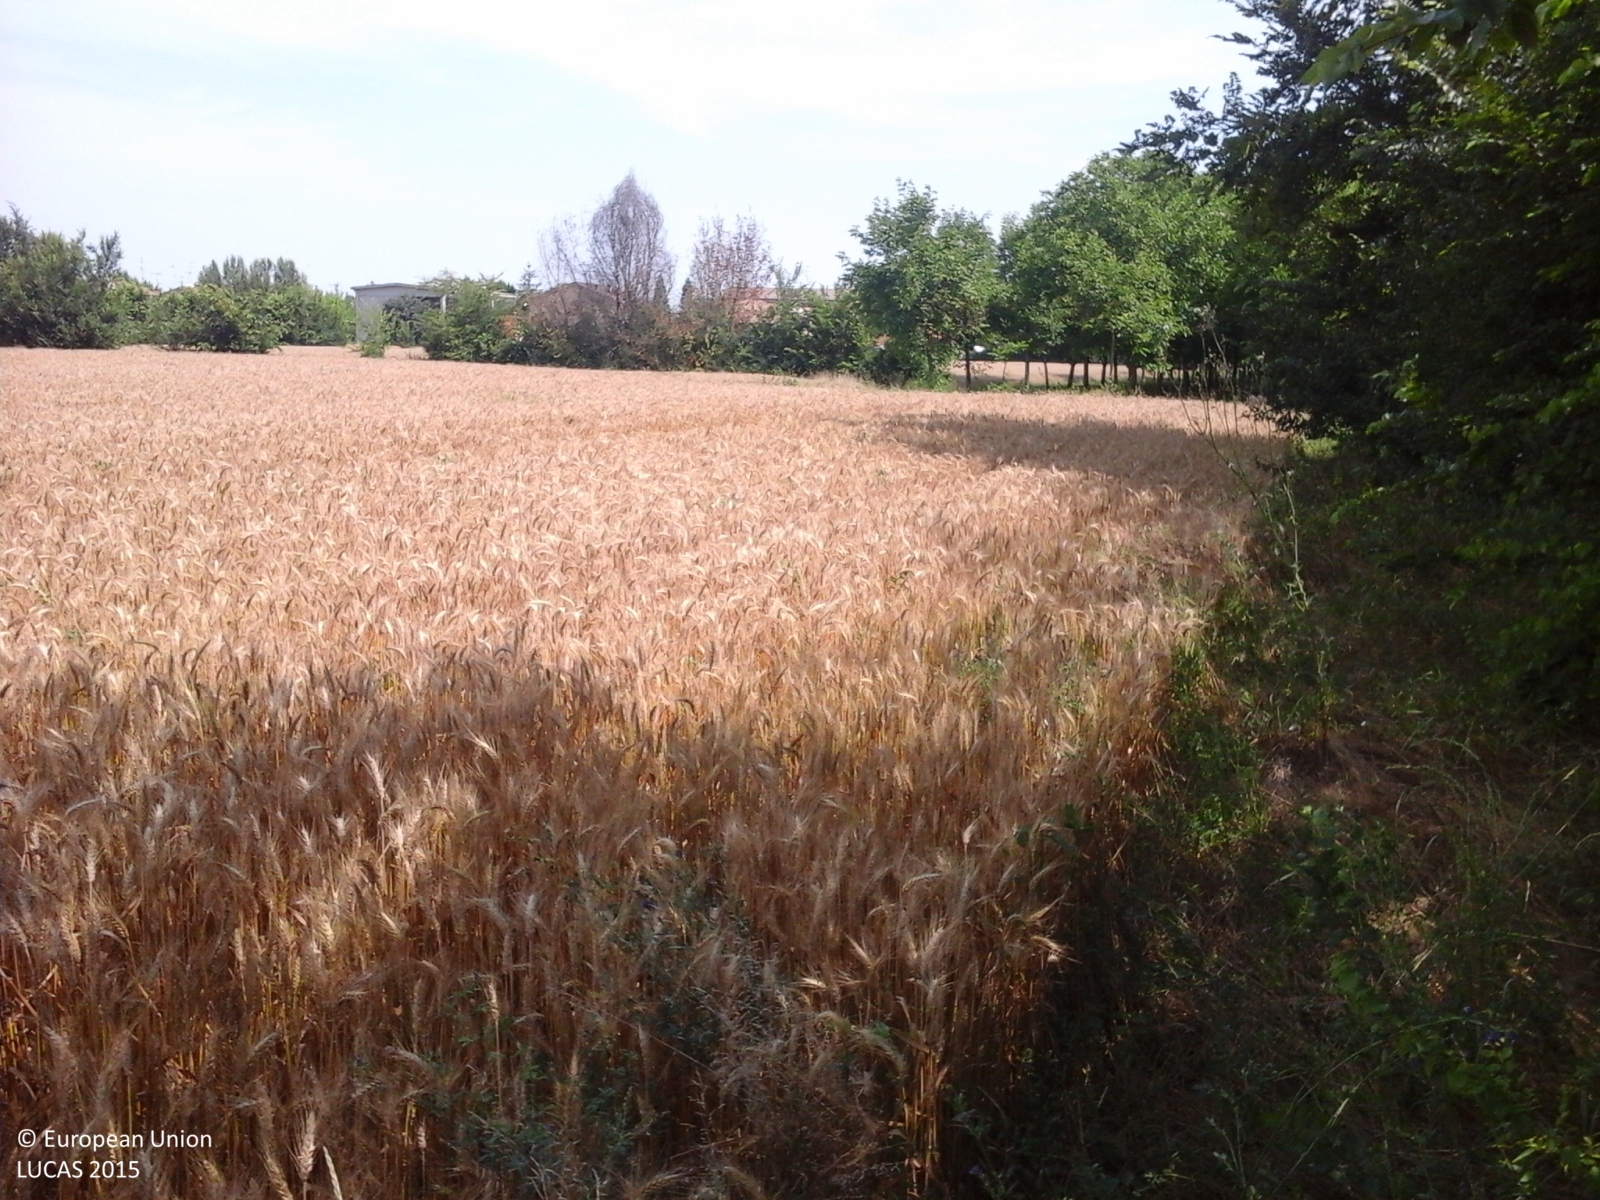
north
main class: Cropland
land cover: Common wheat
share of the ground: > 75 %
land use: Agriculture (excluding fallow land and kitchen gardens)
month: June
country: IT
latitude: 44.6697
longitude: 11.0699
